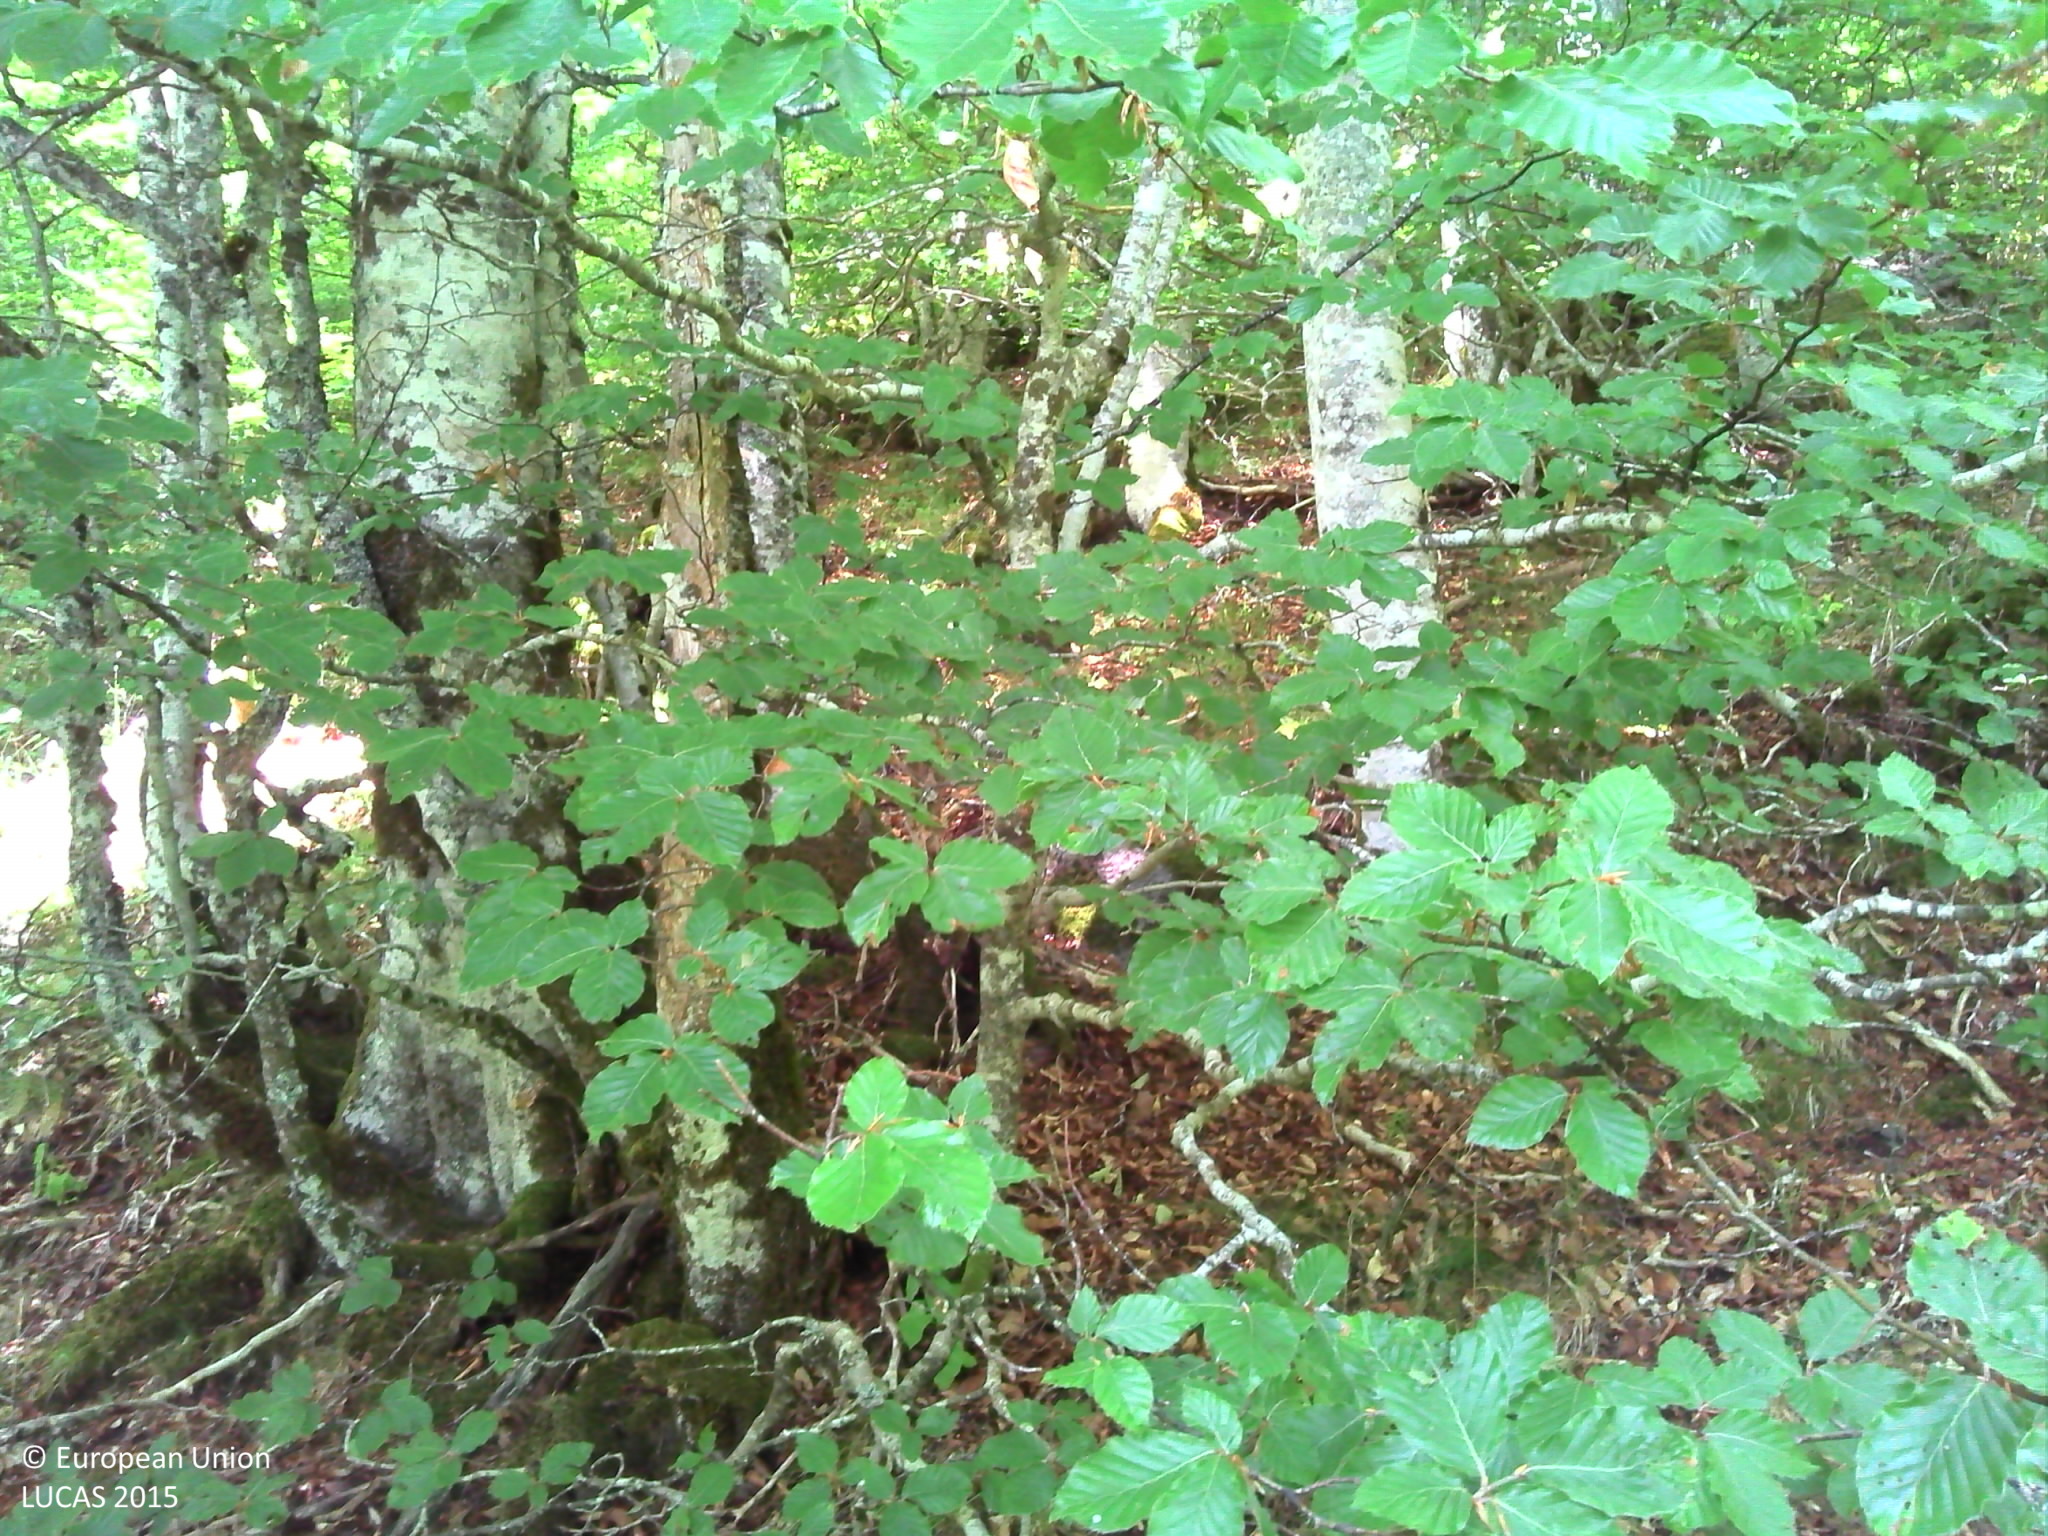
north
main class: Woodland
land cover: Broadleaved woodland
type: beech forest
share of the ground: > 75 %
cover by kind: broadleaved forest trees 80 %, shrubs 15 %, herbaceous plants 5 %
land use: Forestry
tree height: > 5 m
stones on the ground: < 10 %
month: July
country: FR
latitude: 44.6521
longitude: 2.9292
